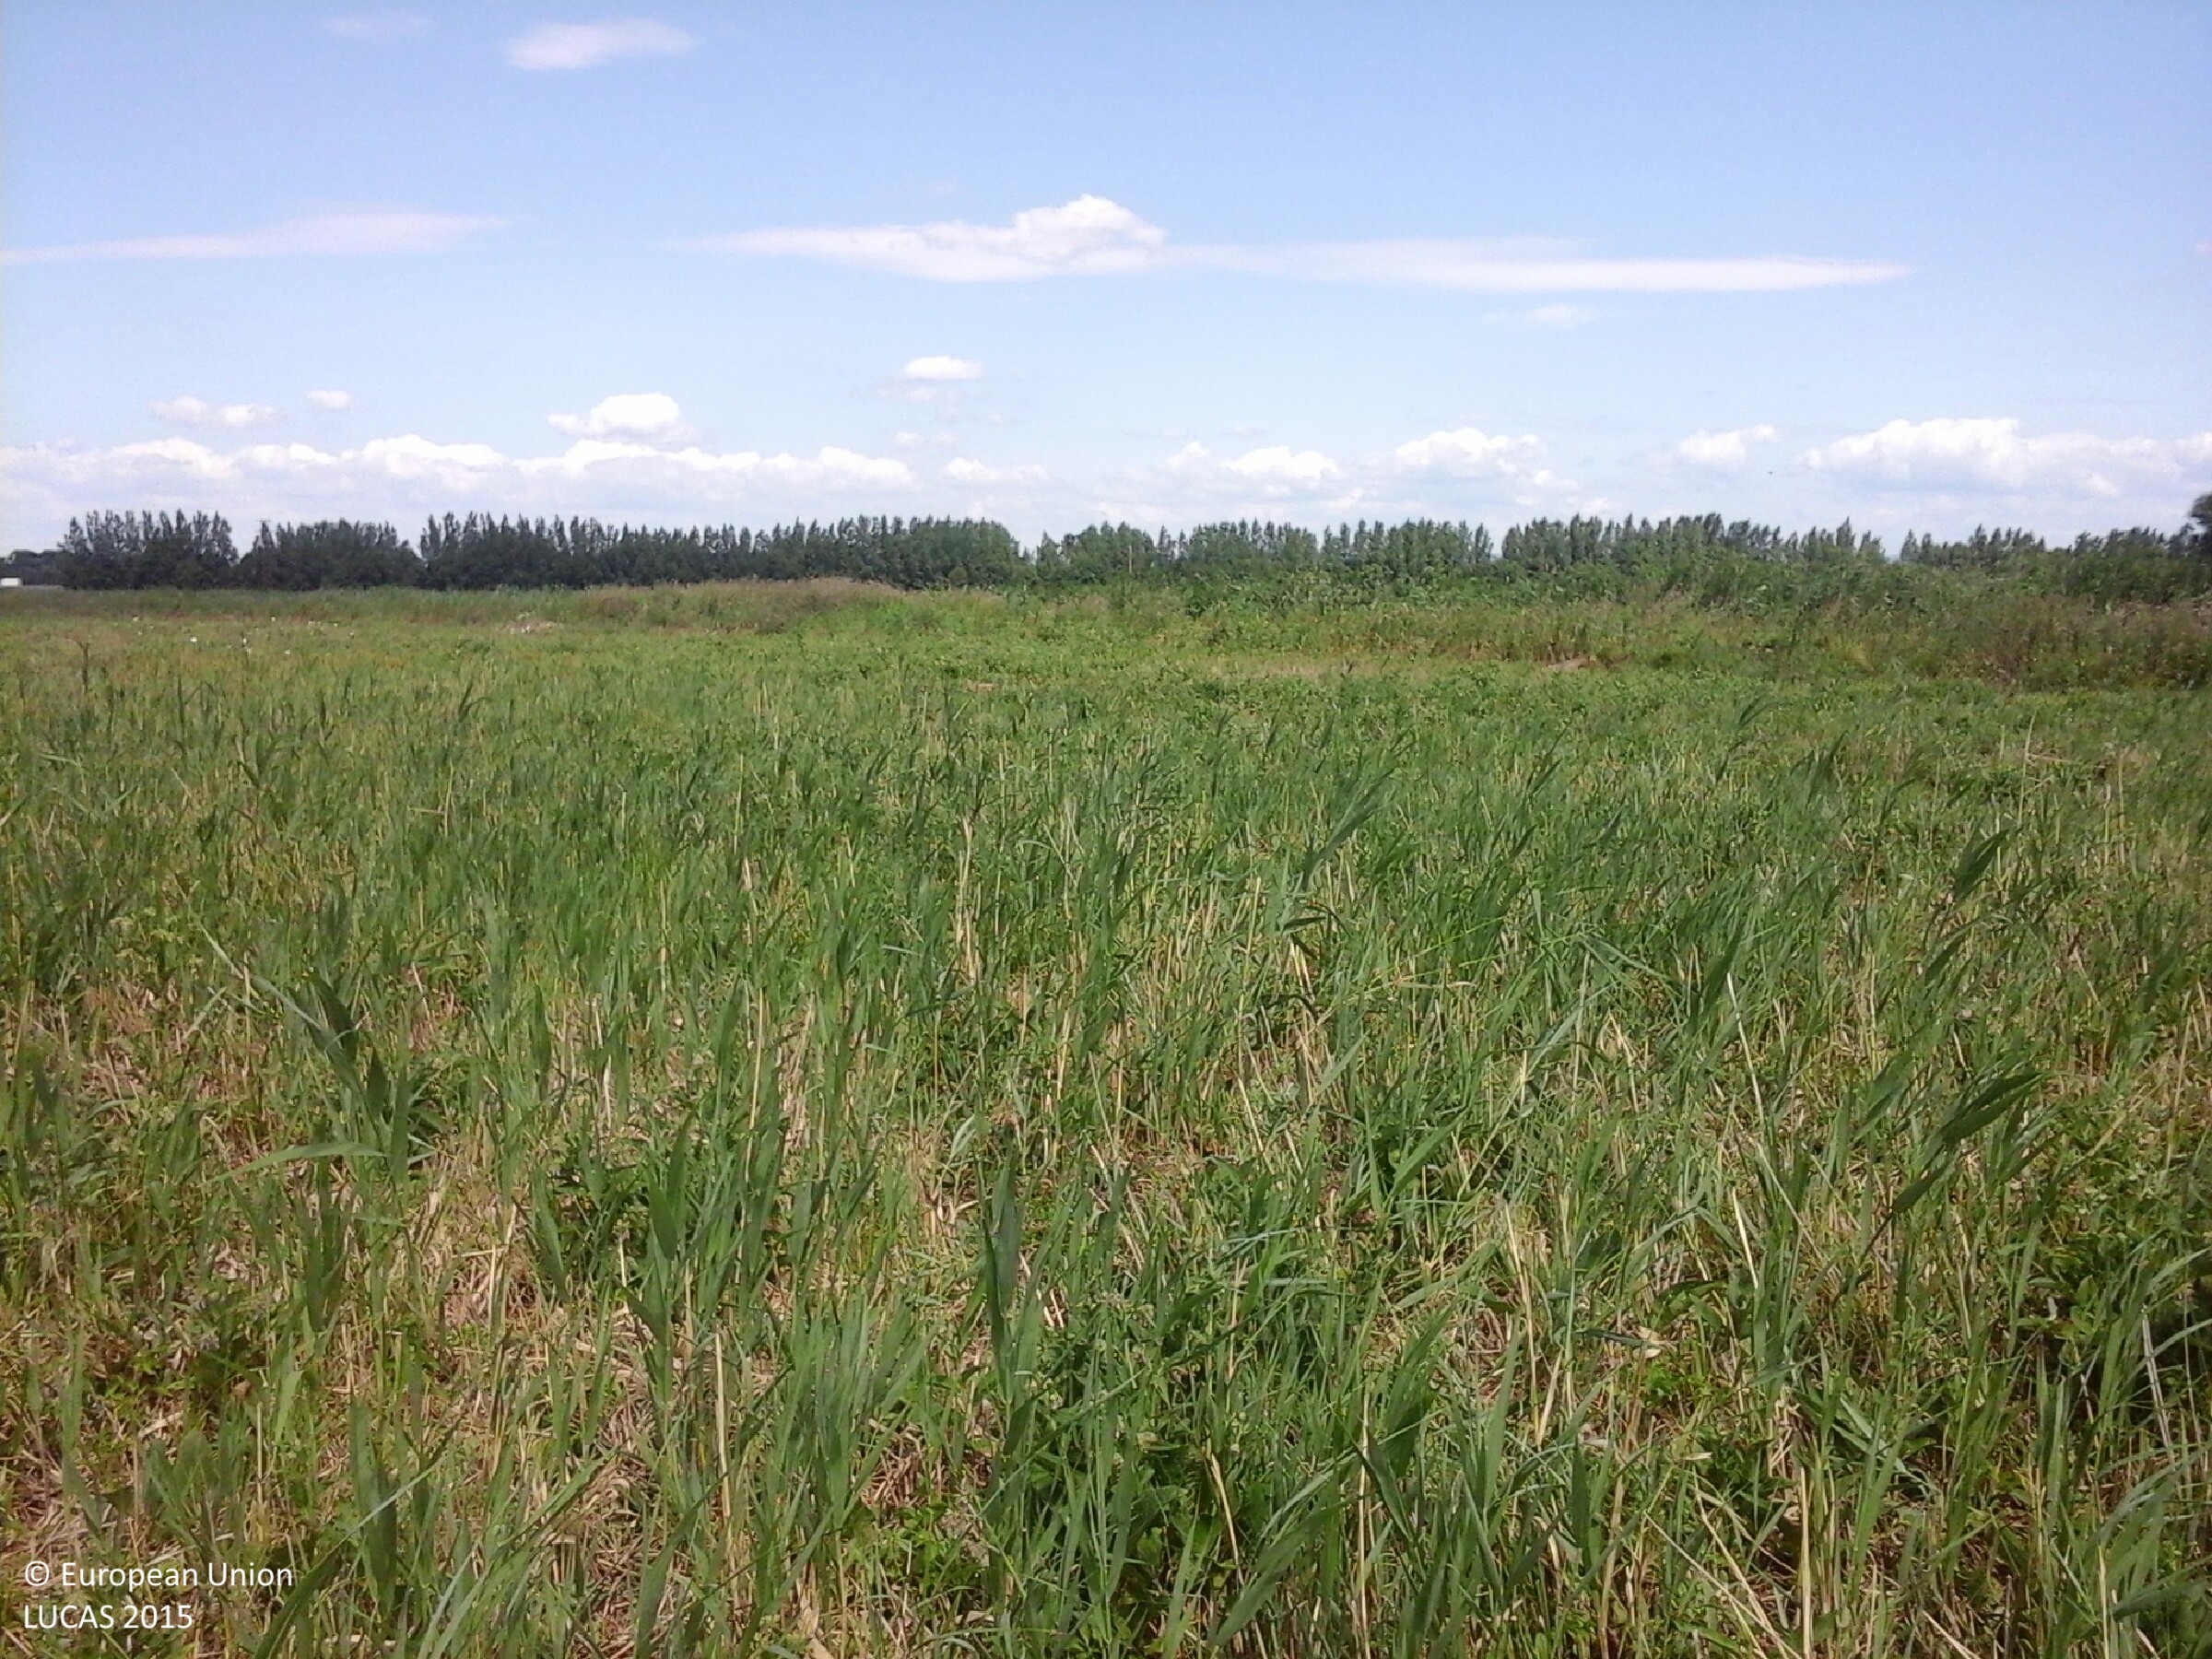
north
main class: Cropland
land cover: Permanent industrial crops
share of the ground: > 75 %
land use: Agriculture (excluding fallow land and kitchen gardens)
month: July
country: HU
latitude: 47.7819
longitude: 20.6174
